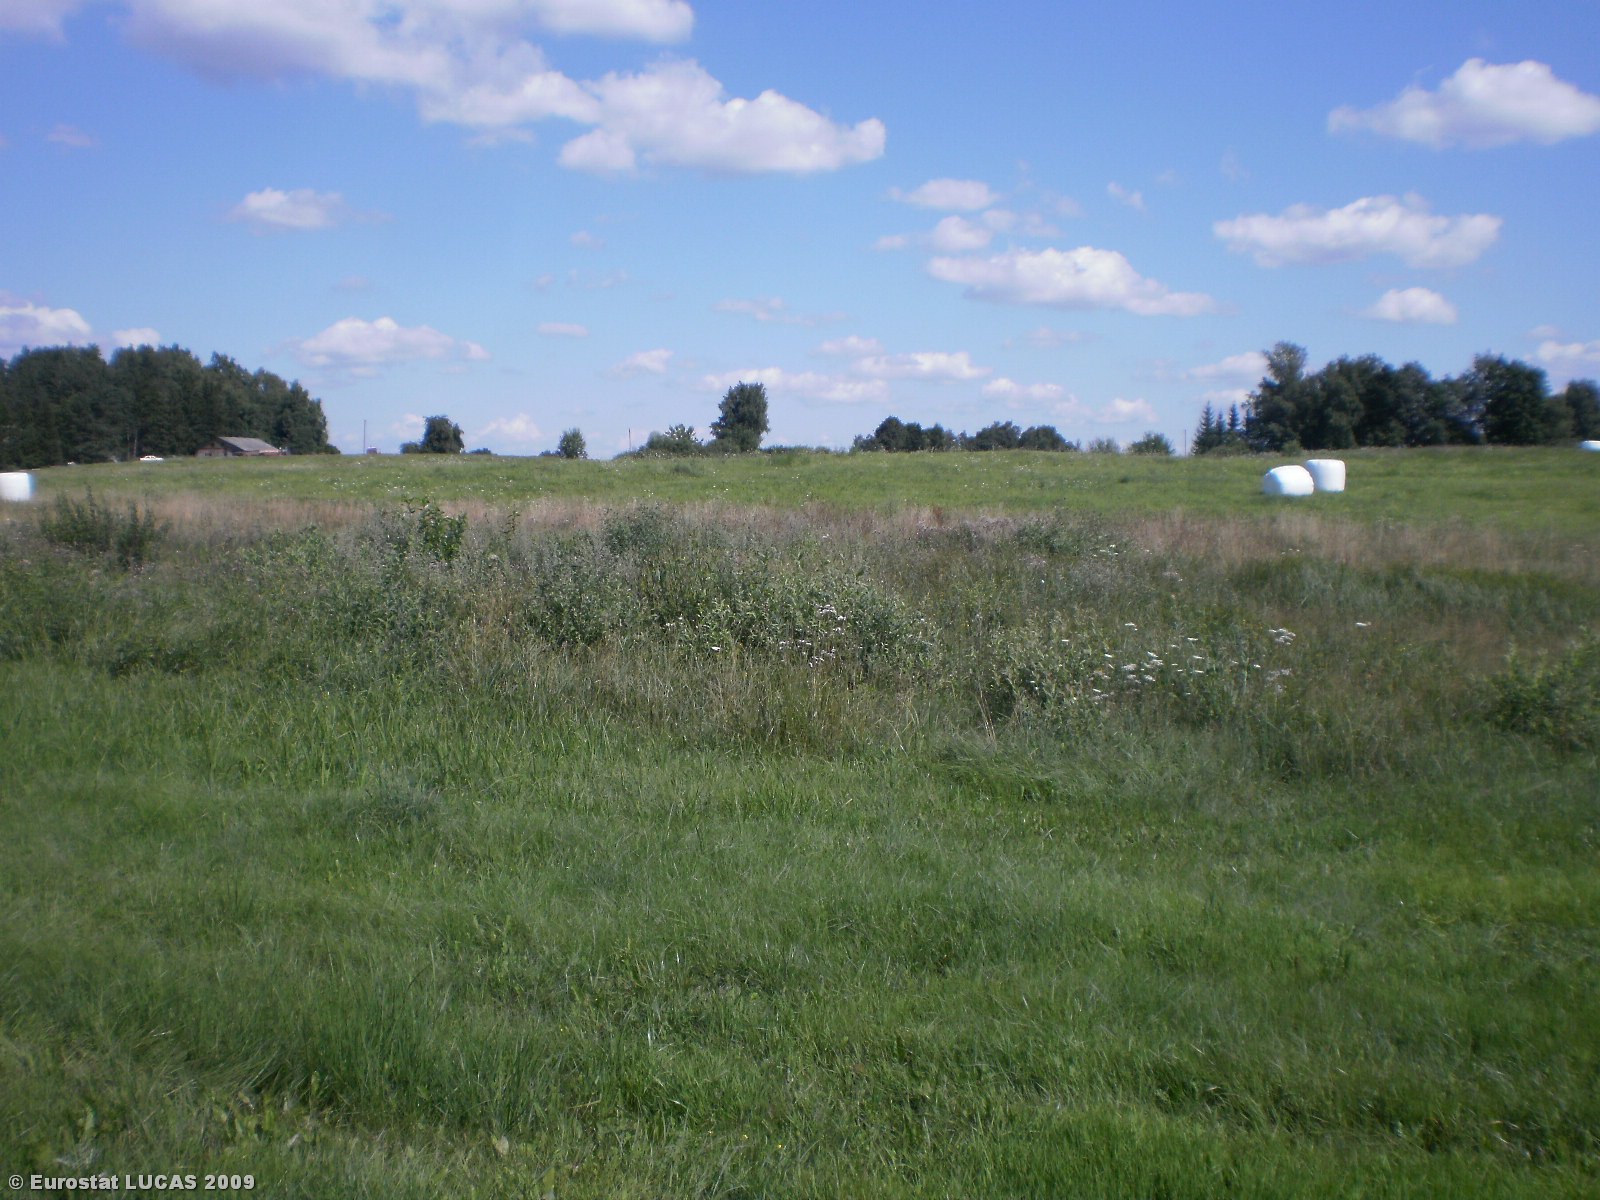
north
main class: Woodland
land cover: Coniferous woodland
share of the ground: 10 - 25 %
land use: Forestry
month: August
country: LT
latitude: 55.7833
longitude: 25.0857
